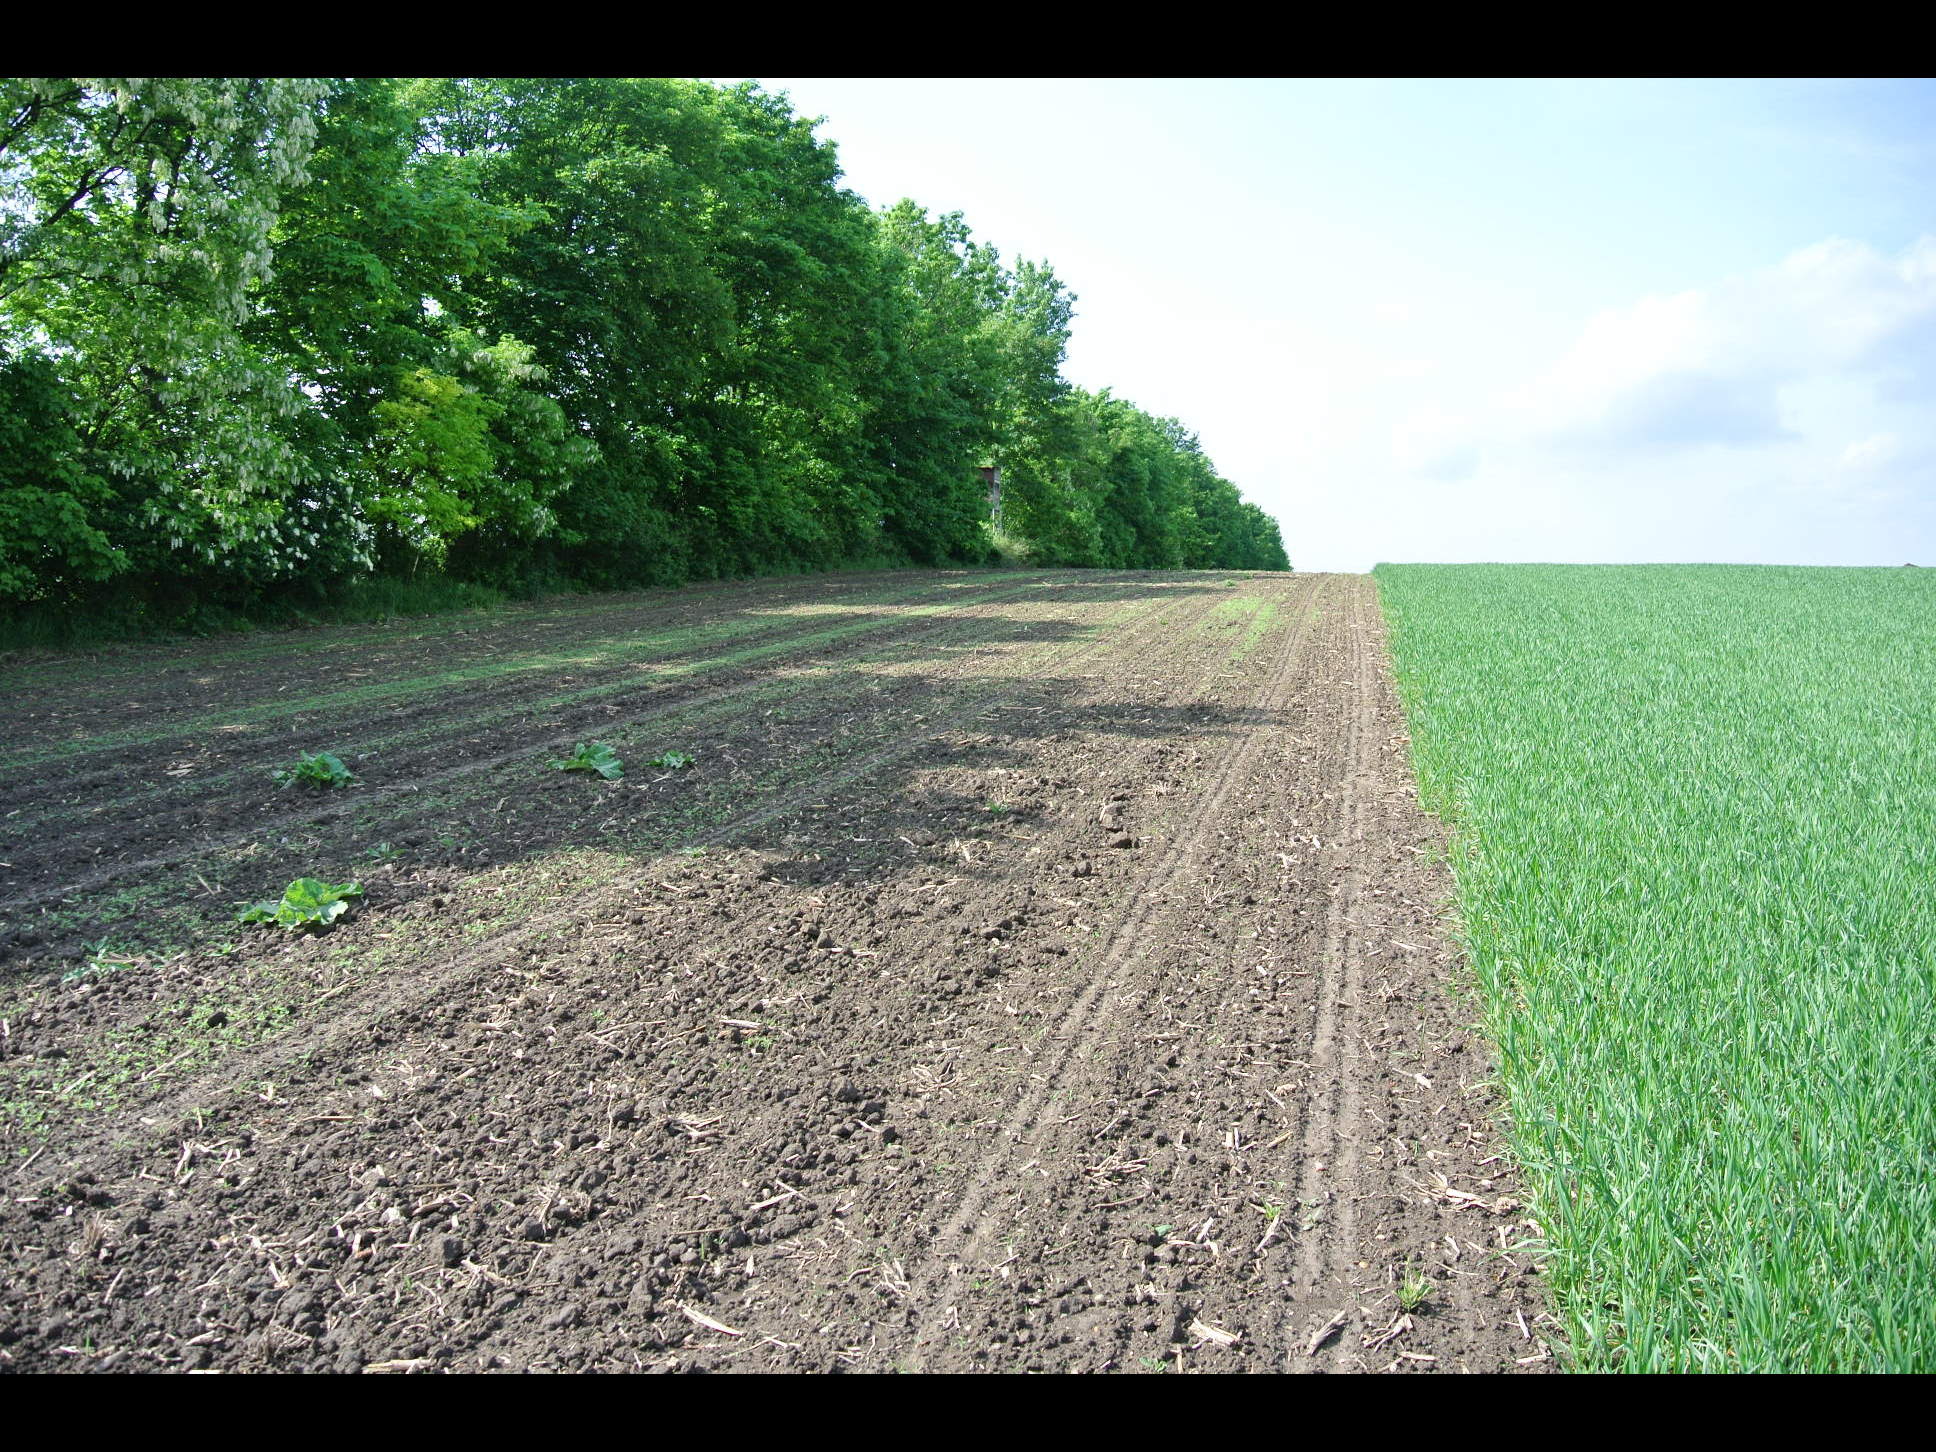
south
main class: Cropland
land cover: Barley
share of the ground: > 75 %
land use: Agriculture (excluding fallow land and kitchen gardens)
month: May
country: AT
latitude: 48.0410
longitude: 16.6452
